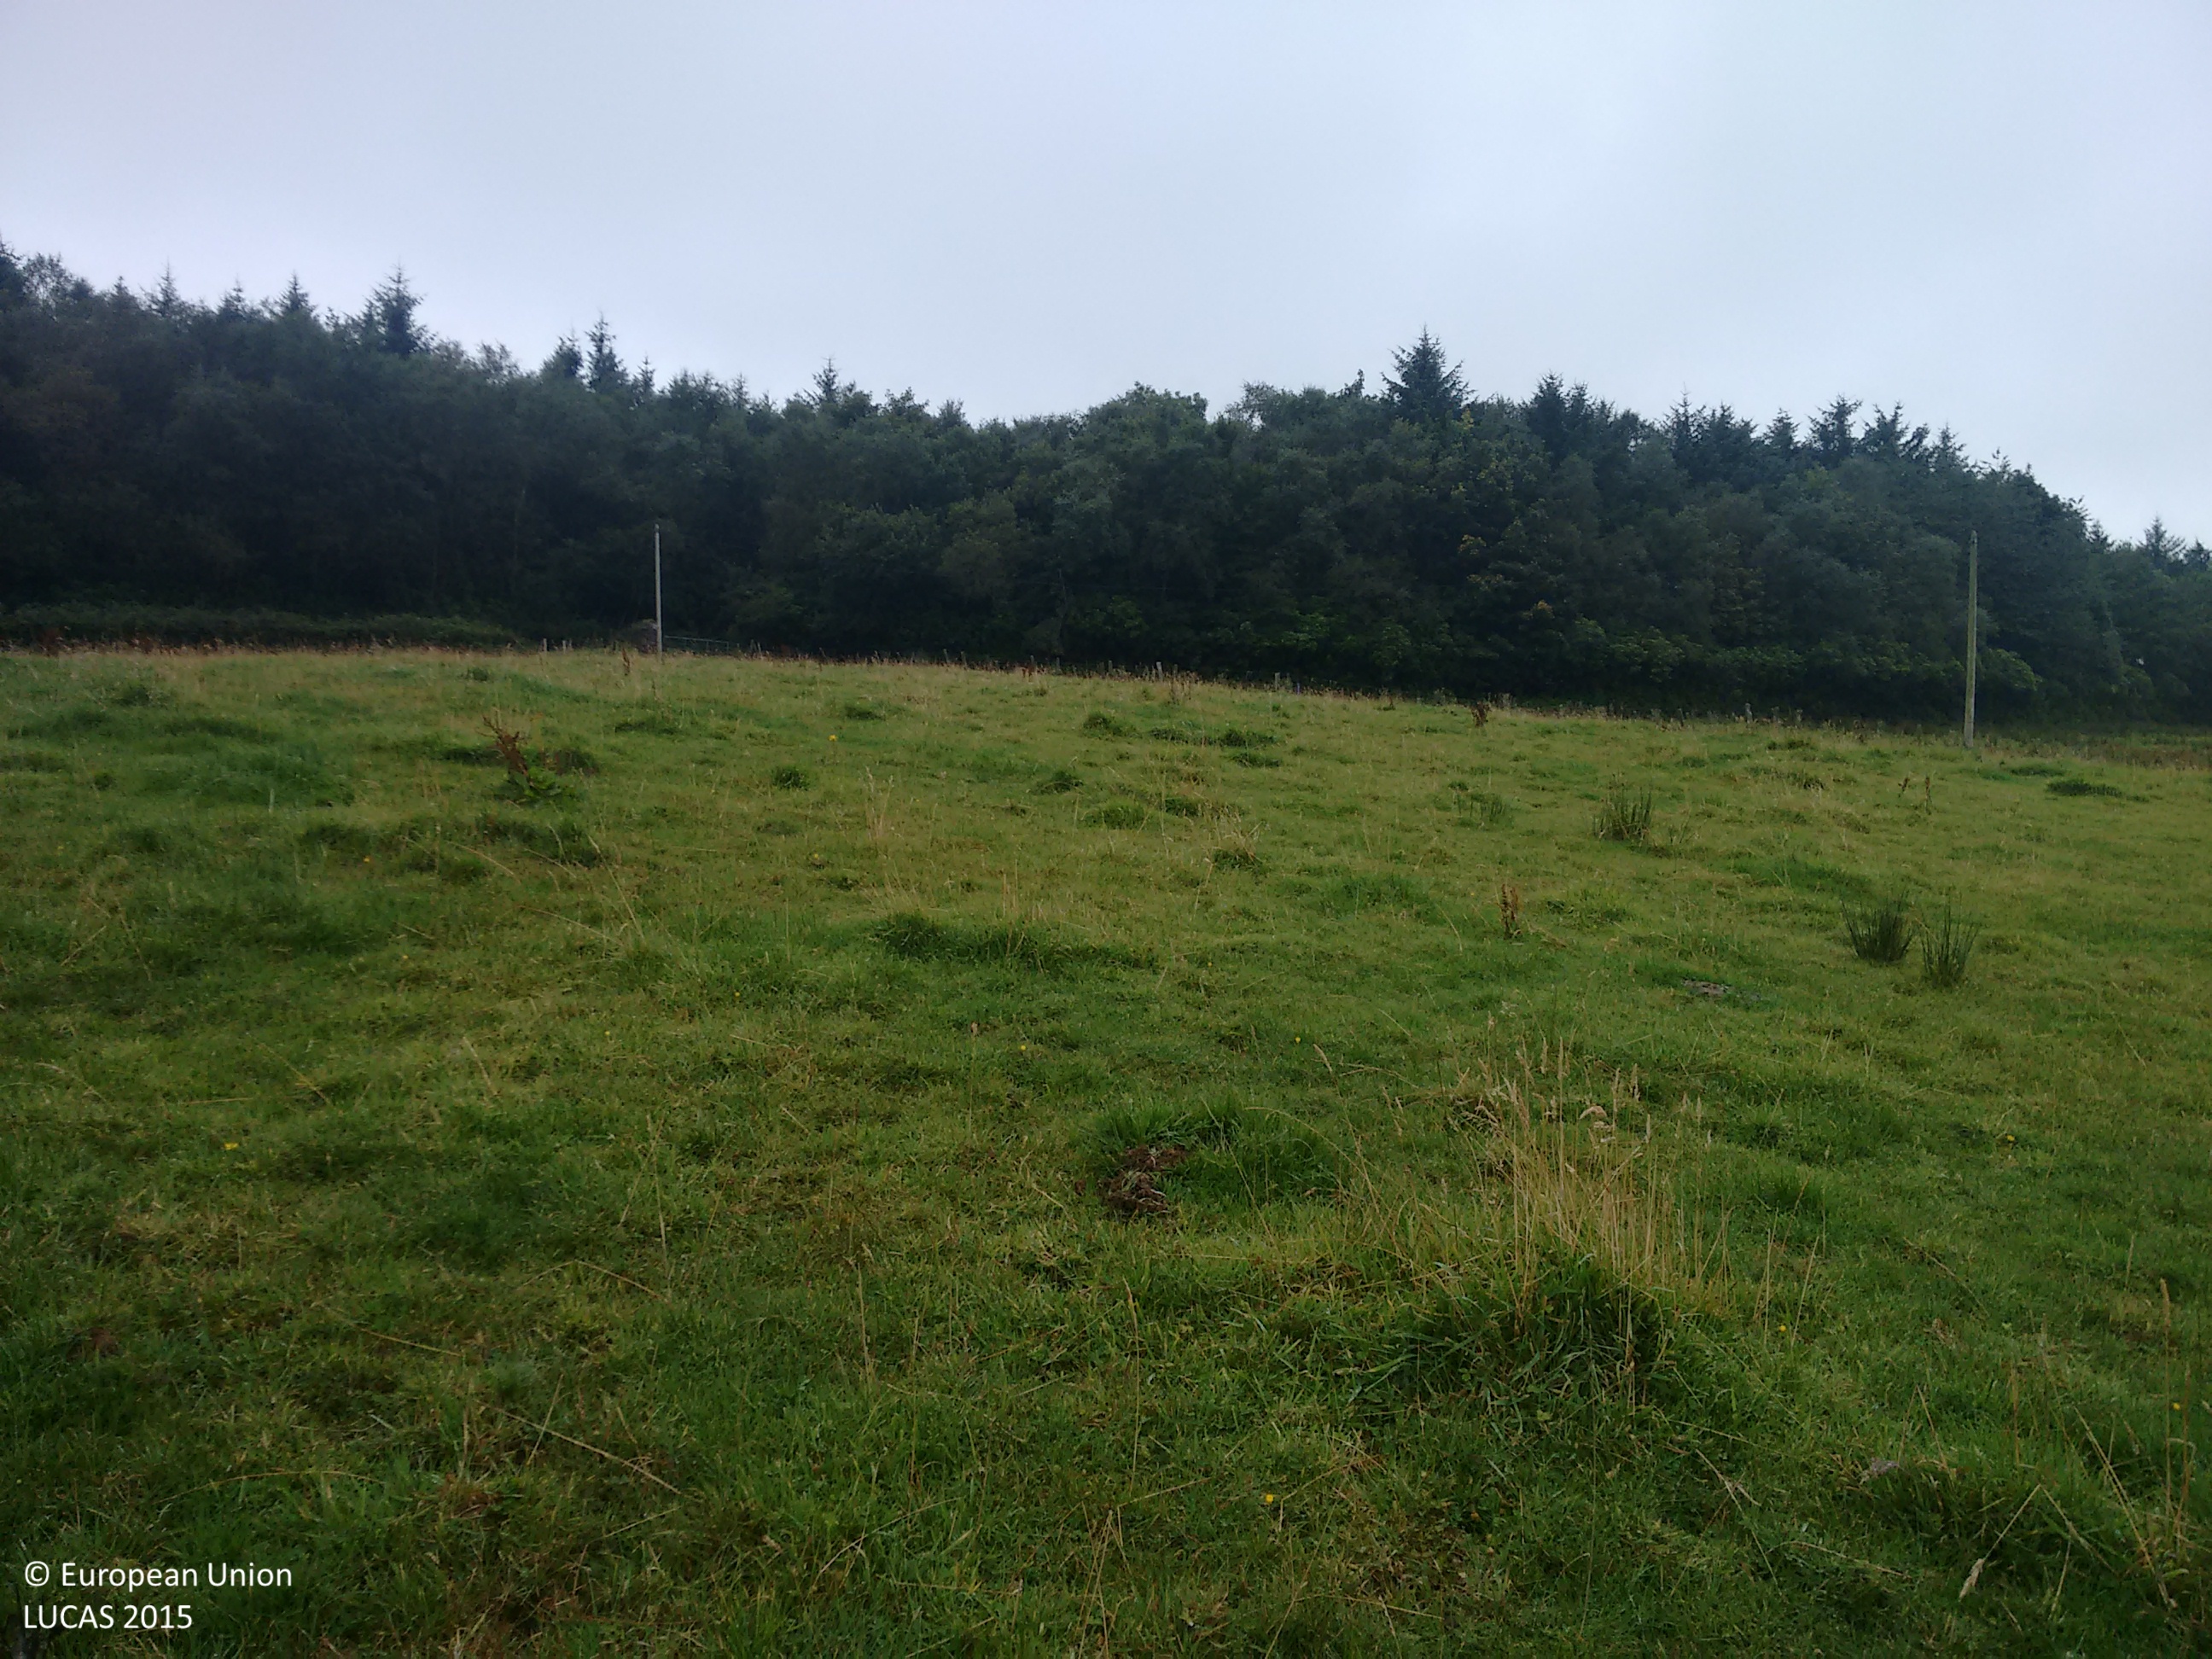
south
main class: Grassland
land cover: Grassland without tree/shrub cover
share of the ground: > 75 %
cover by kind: herbaceous plants 100 %
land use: Agriculture (excluding fallow land and kitchen gardens)
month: September
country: IE
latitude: 55.0644
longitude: -7.3574
